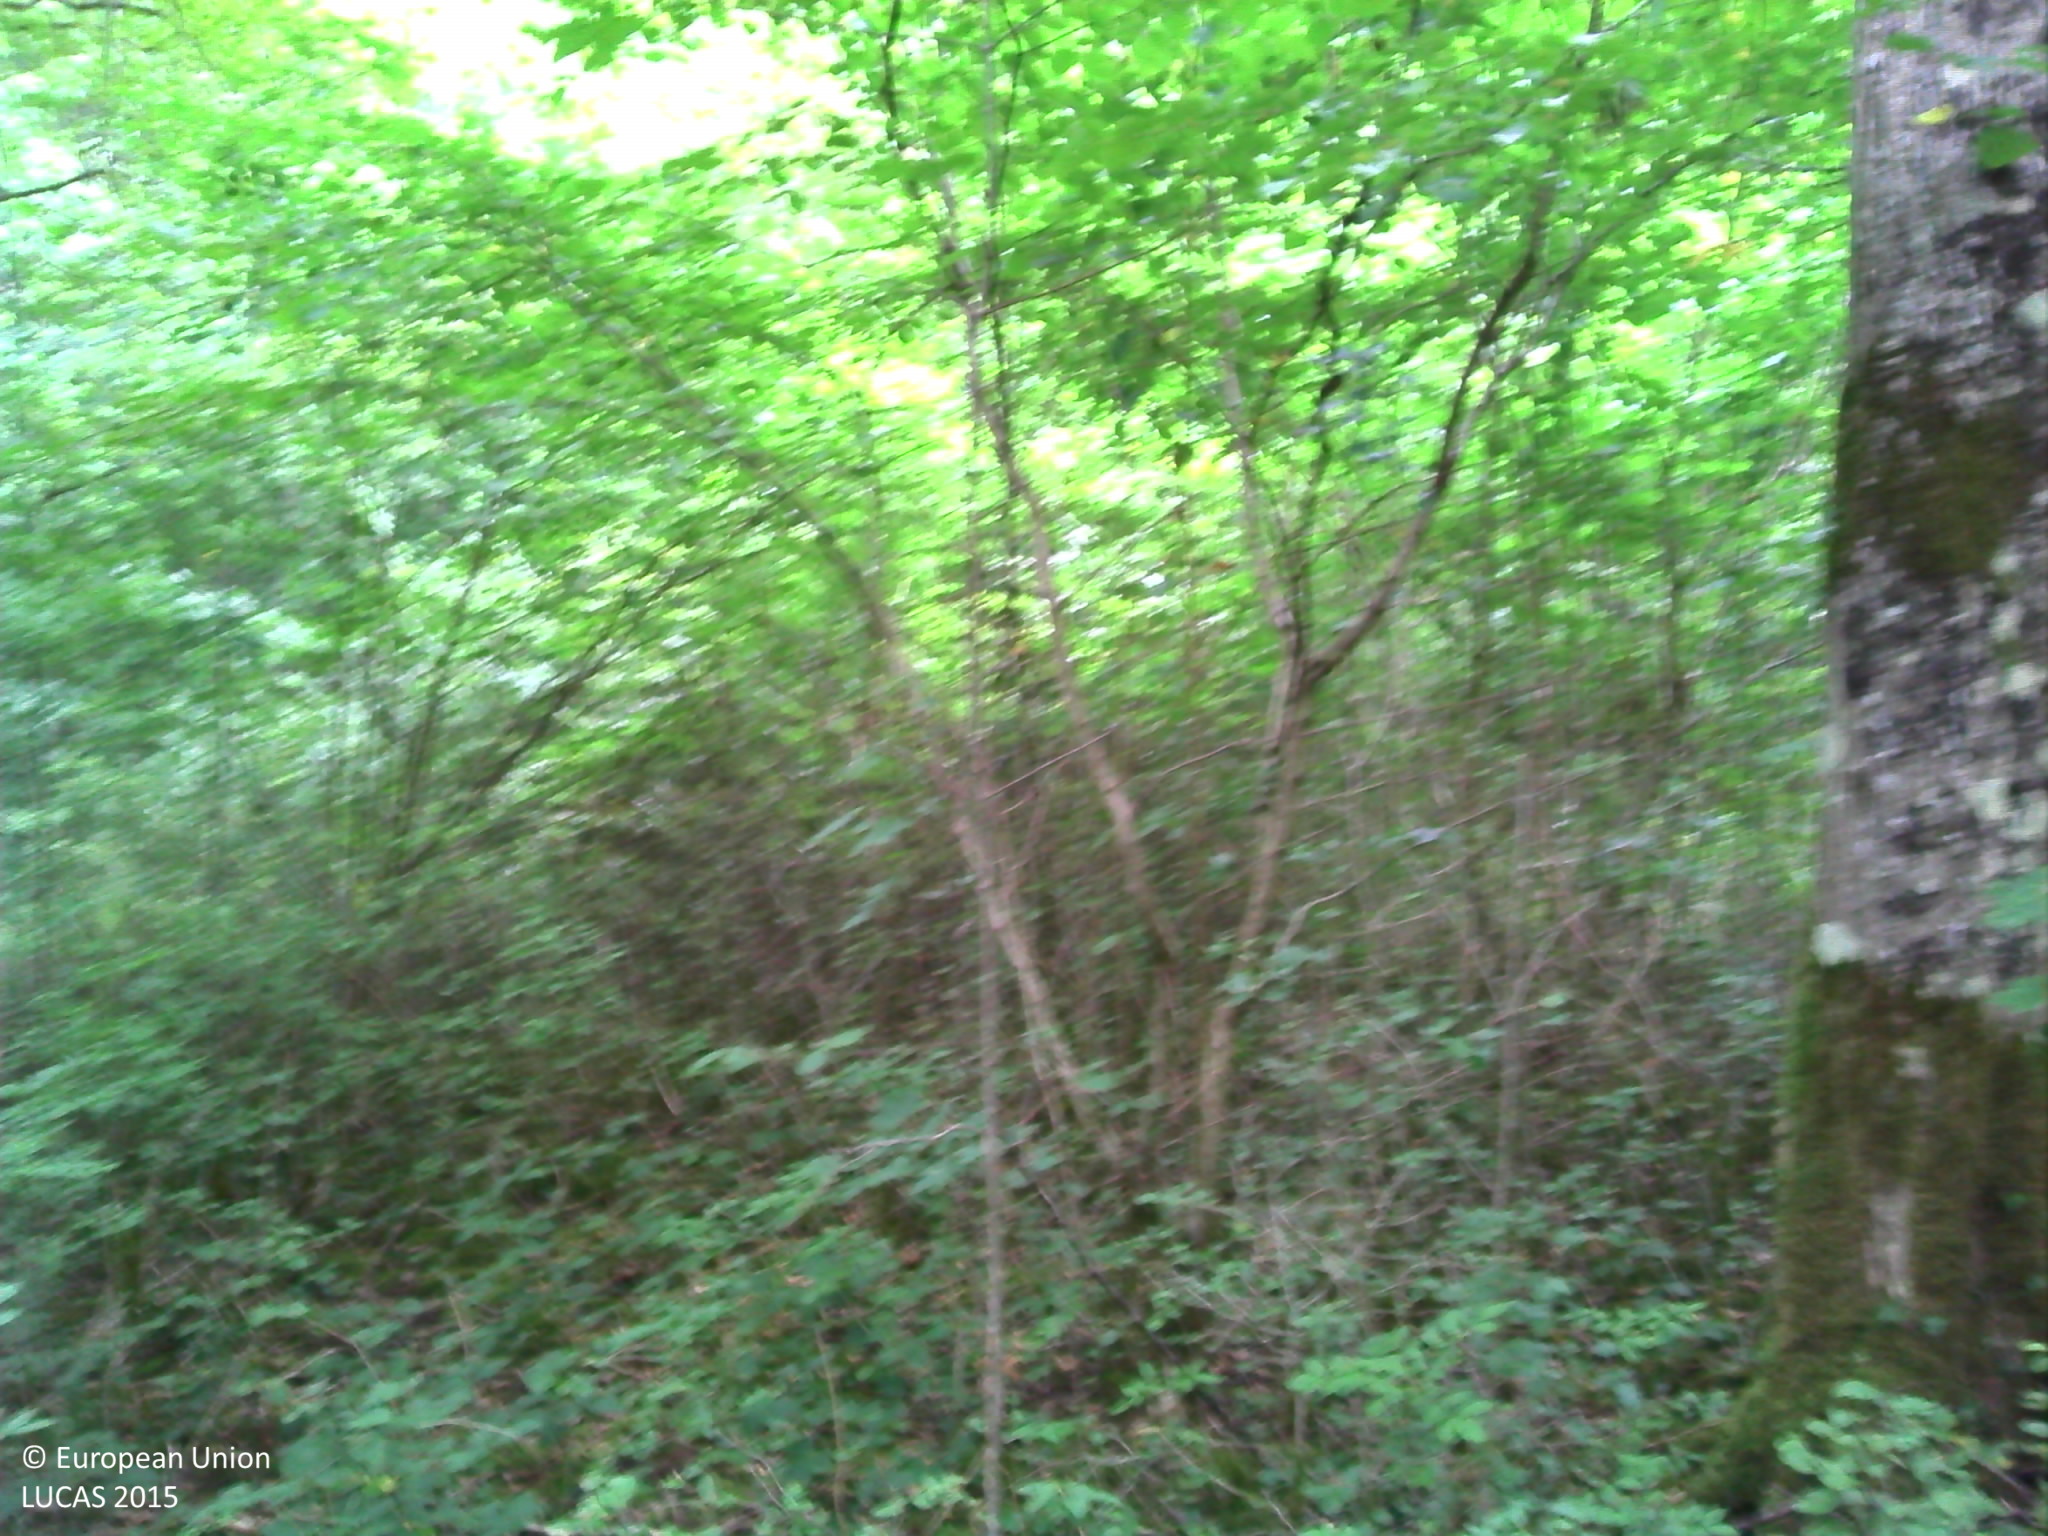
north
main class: Woodland
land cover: Broadleaved woodland
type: mesophytic deciduous forest
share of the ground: > 75 %
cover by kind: broadleaved forest trees 80 %, herbaceous plants 10 %, lichens and mosses 10 %
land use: Forestry
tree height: > 5 m
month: July
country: FR
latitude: 47.9767
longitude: 5.2438
